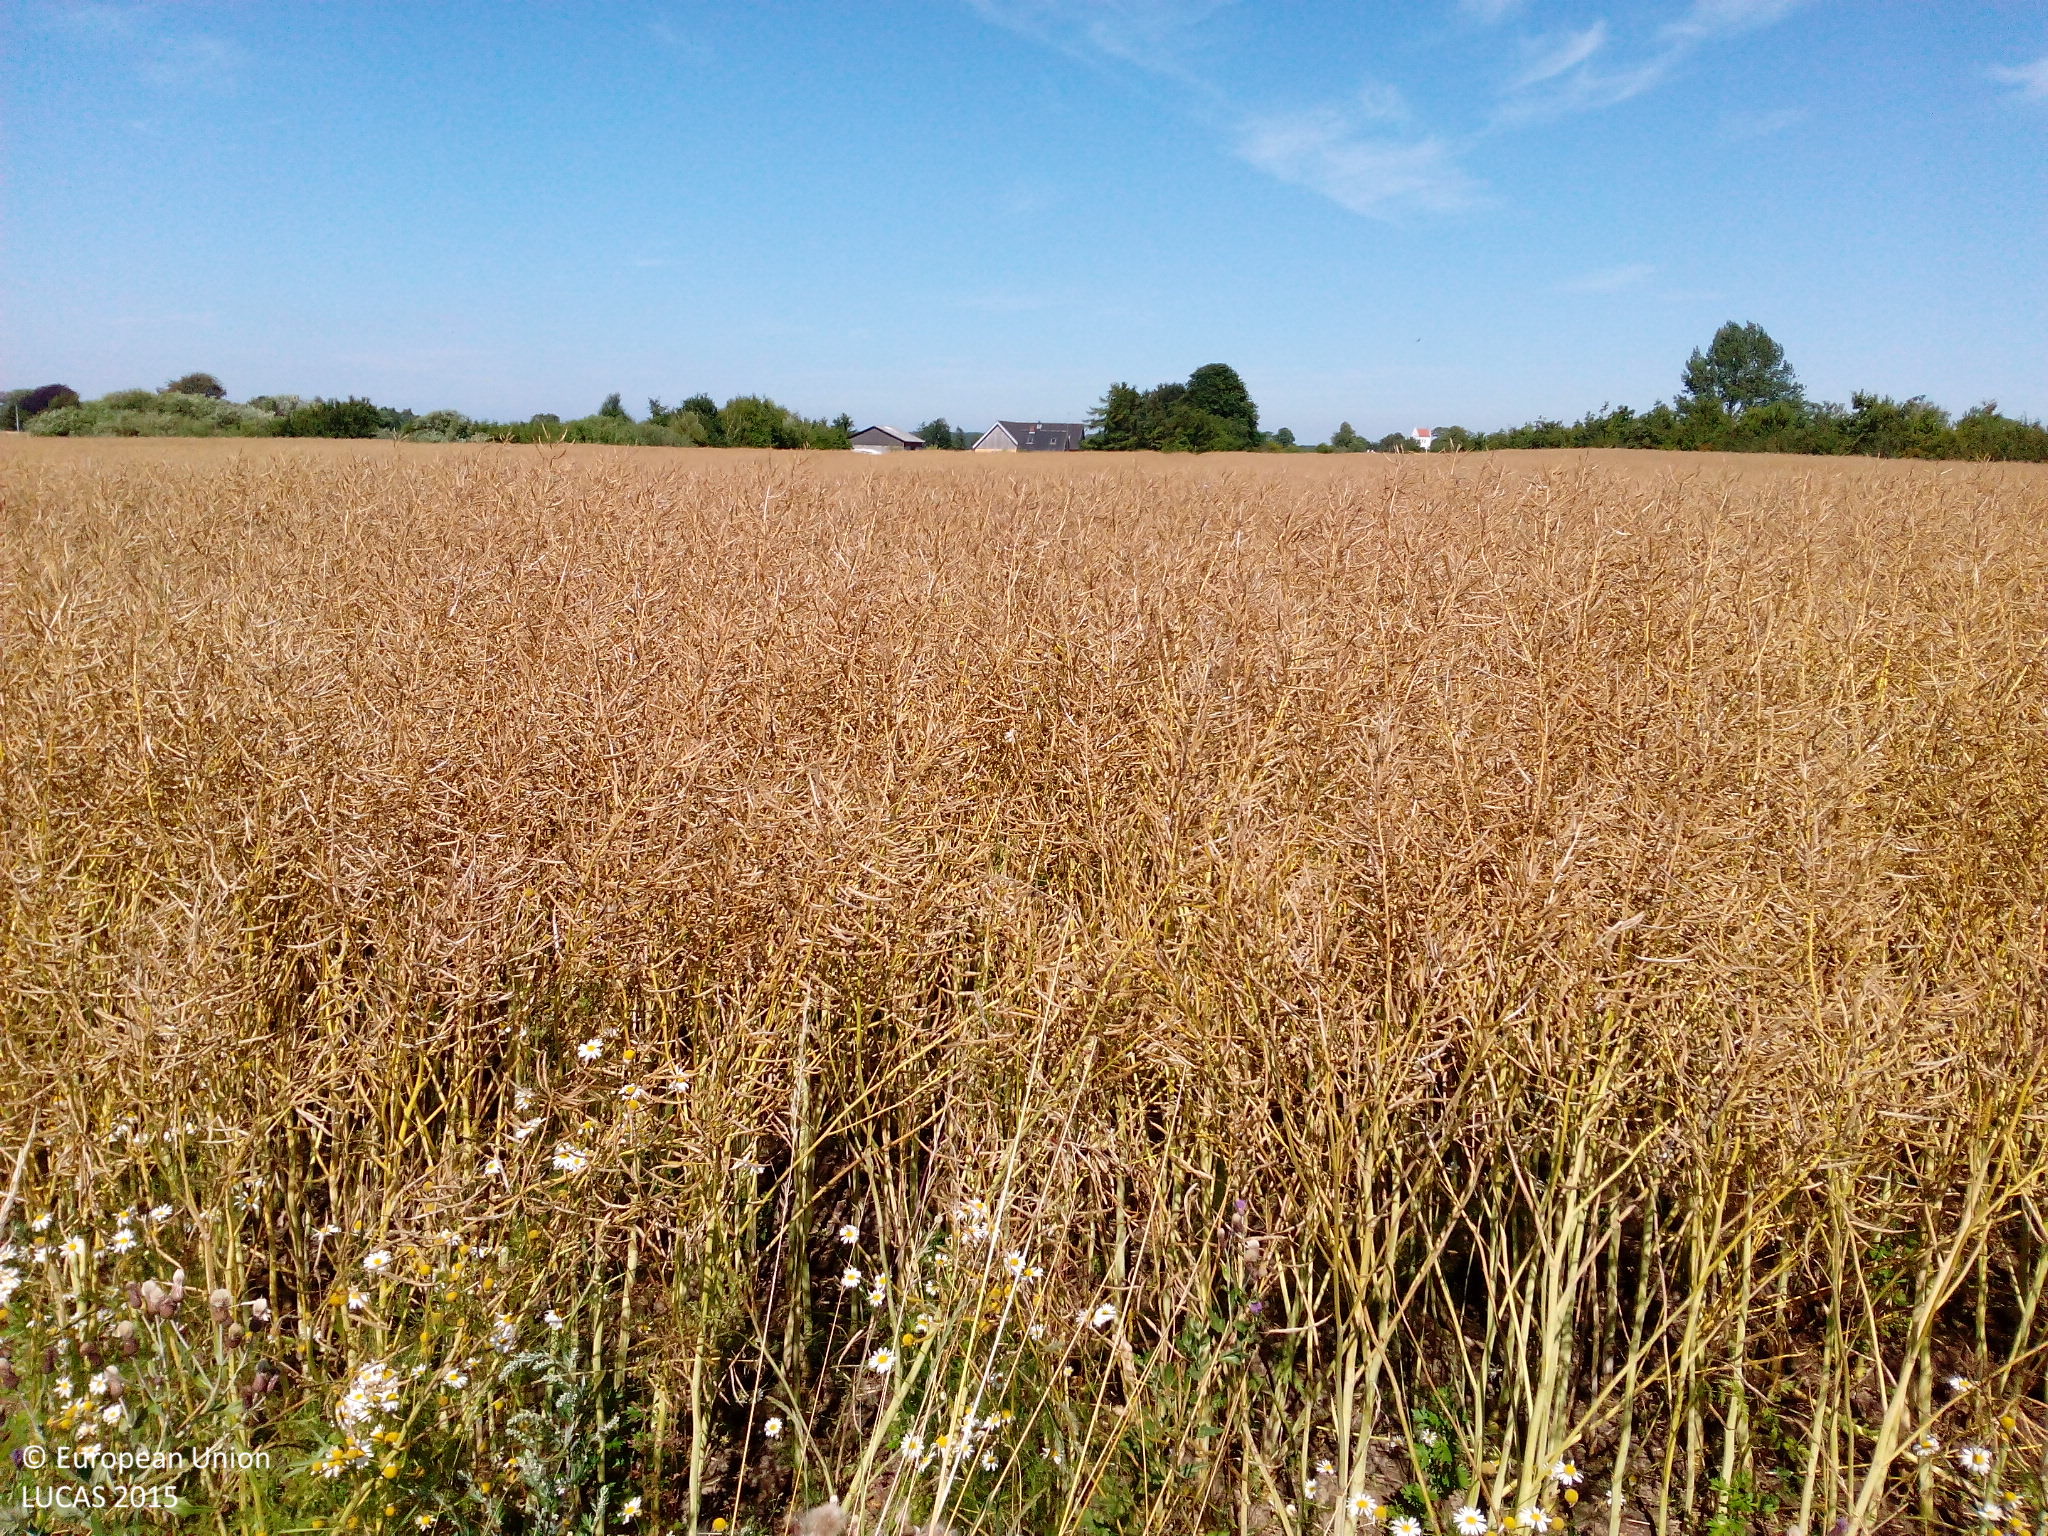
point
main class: Cropland
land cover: Rape and turnip rape
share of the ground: > 75 %
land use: Agriculture (excluding fallow land and kitchen gardens)
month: August
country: DK
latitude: 55.5999
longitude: 11.7918
